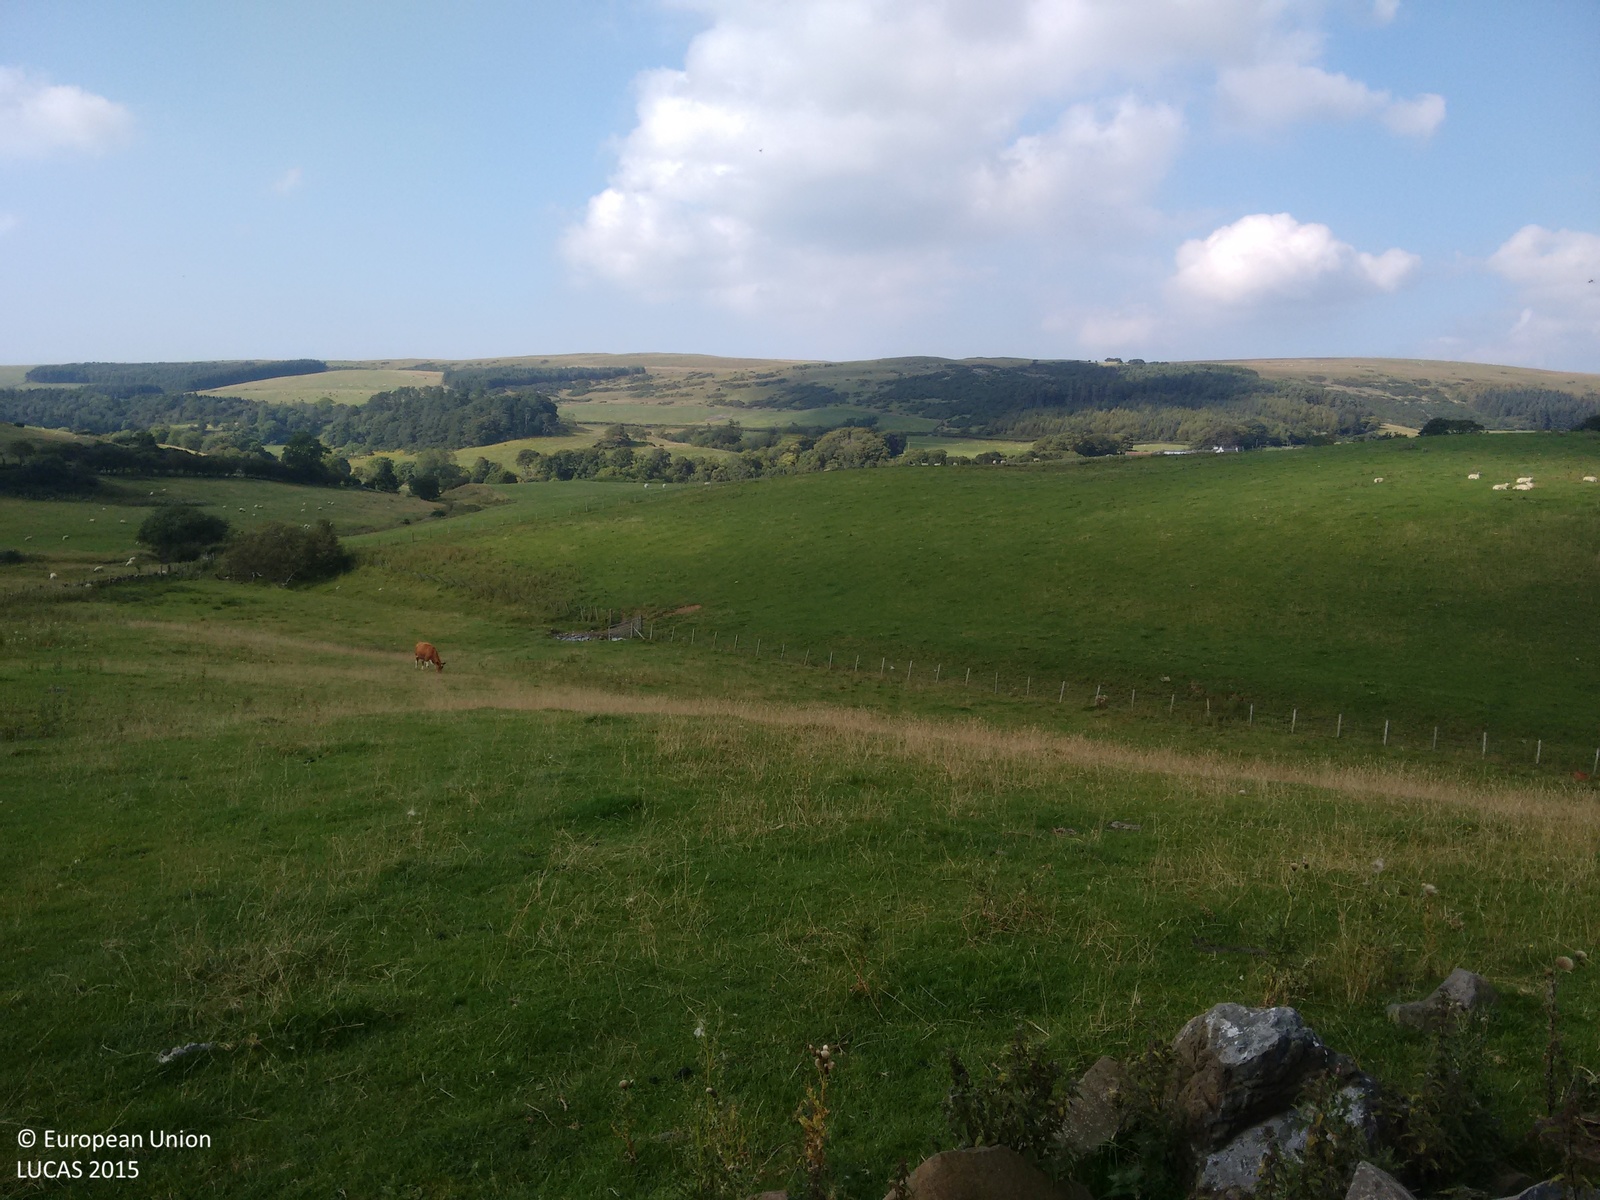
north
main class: Grassland
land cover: Grassland without tree/shrub cover
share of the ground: > 75 %
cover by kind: herbaceous plants 100 %
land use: Agriculture (excluding fallow land and kitchen gardens)
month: September
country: GB
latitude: 55.1239
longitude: -4.9303
